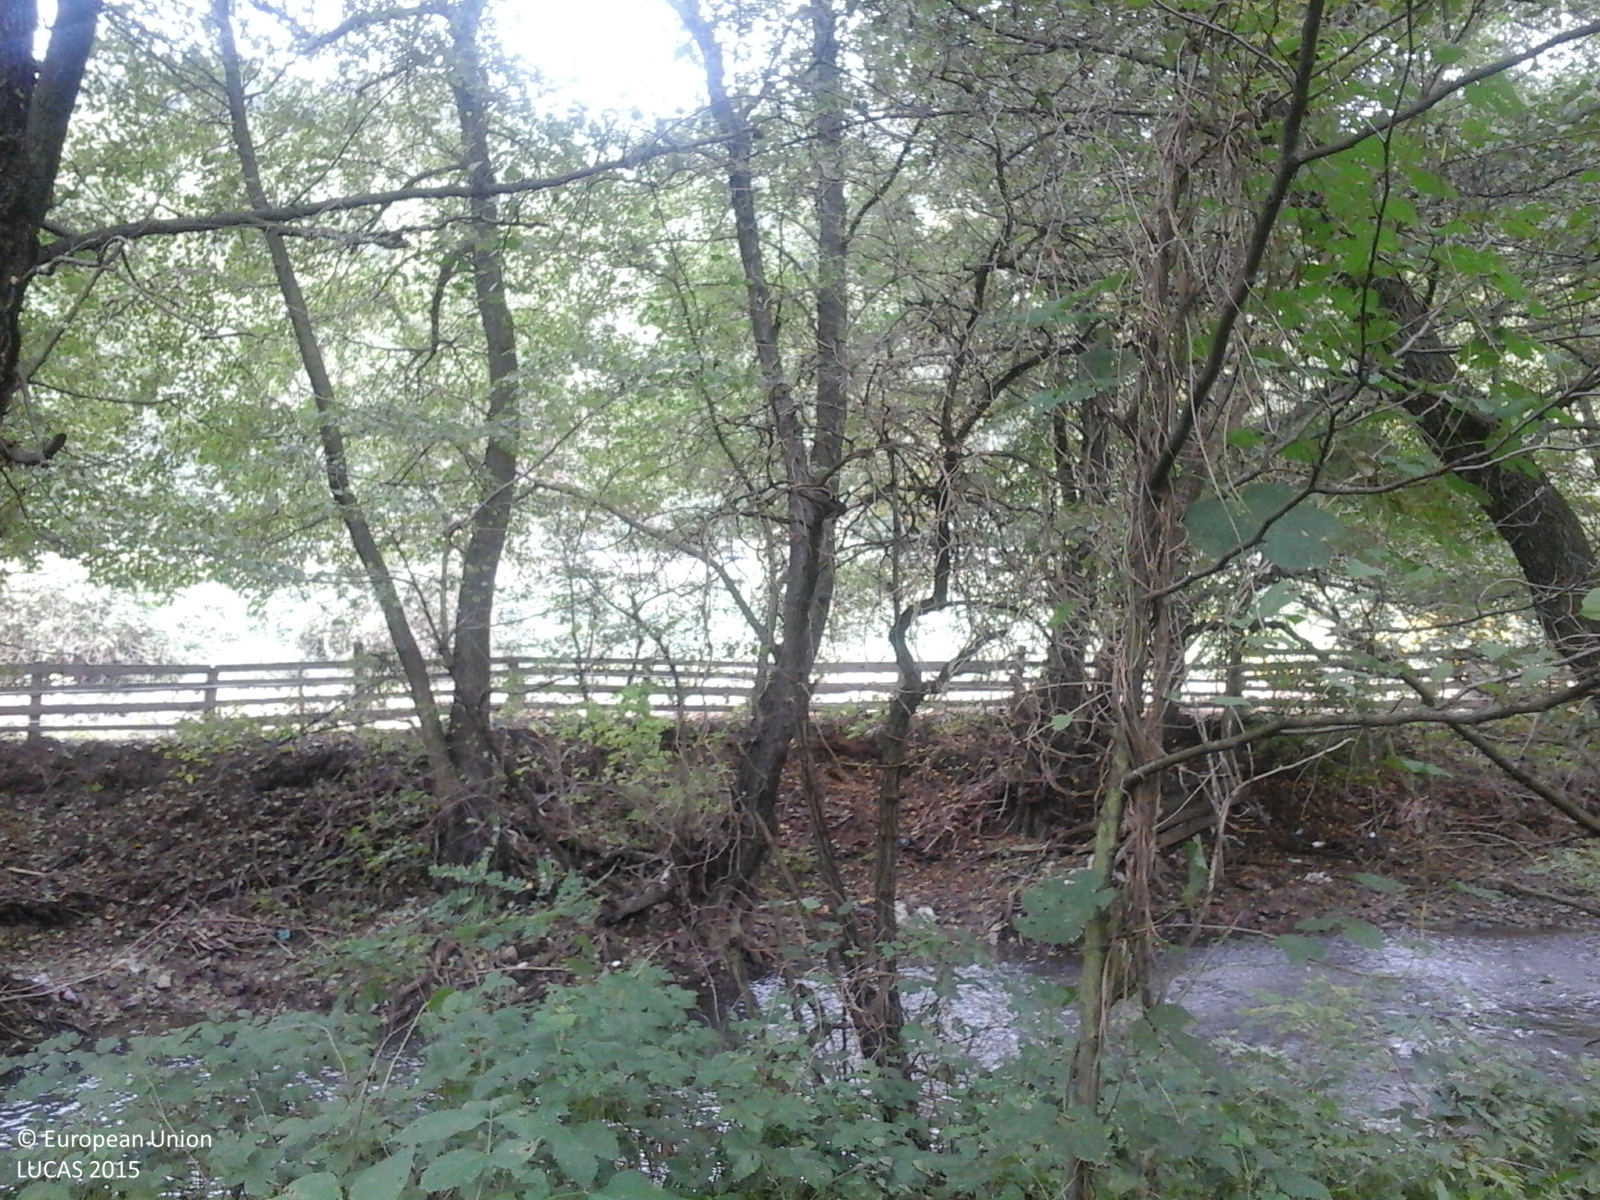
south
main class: Woodland
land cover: Broadleaved woodland
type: floodplain forest
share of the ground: > 75 %
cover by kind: broadleaved forest trees 80 %, herbaceous plants 15 %, shrubs 5 %
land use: Forestry
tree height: > 5 m
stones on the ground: < 10 %
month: October
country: RO
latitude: 46.0910
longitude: 23.3716
